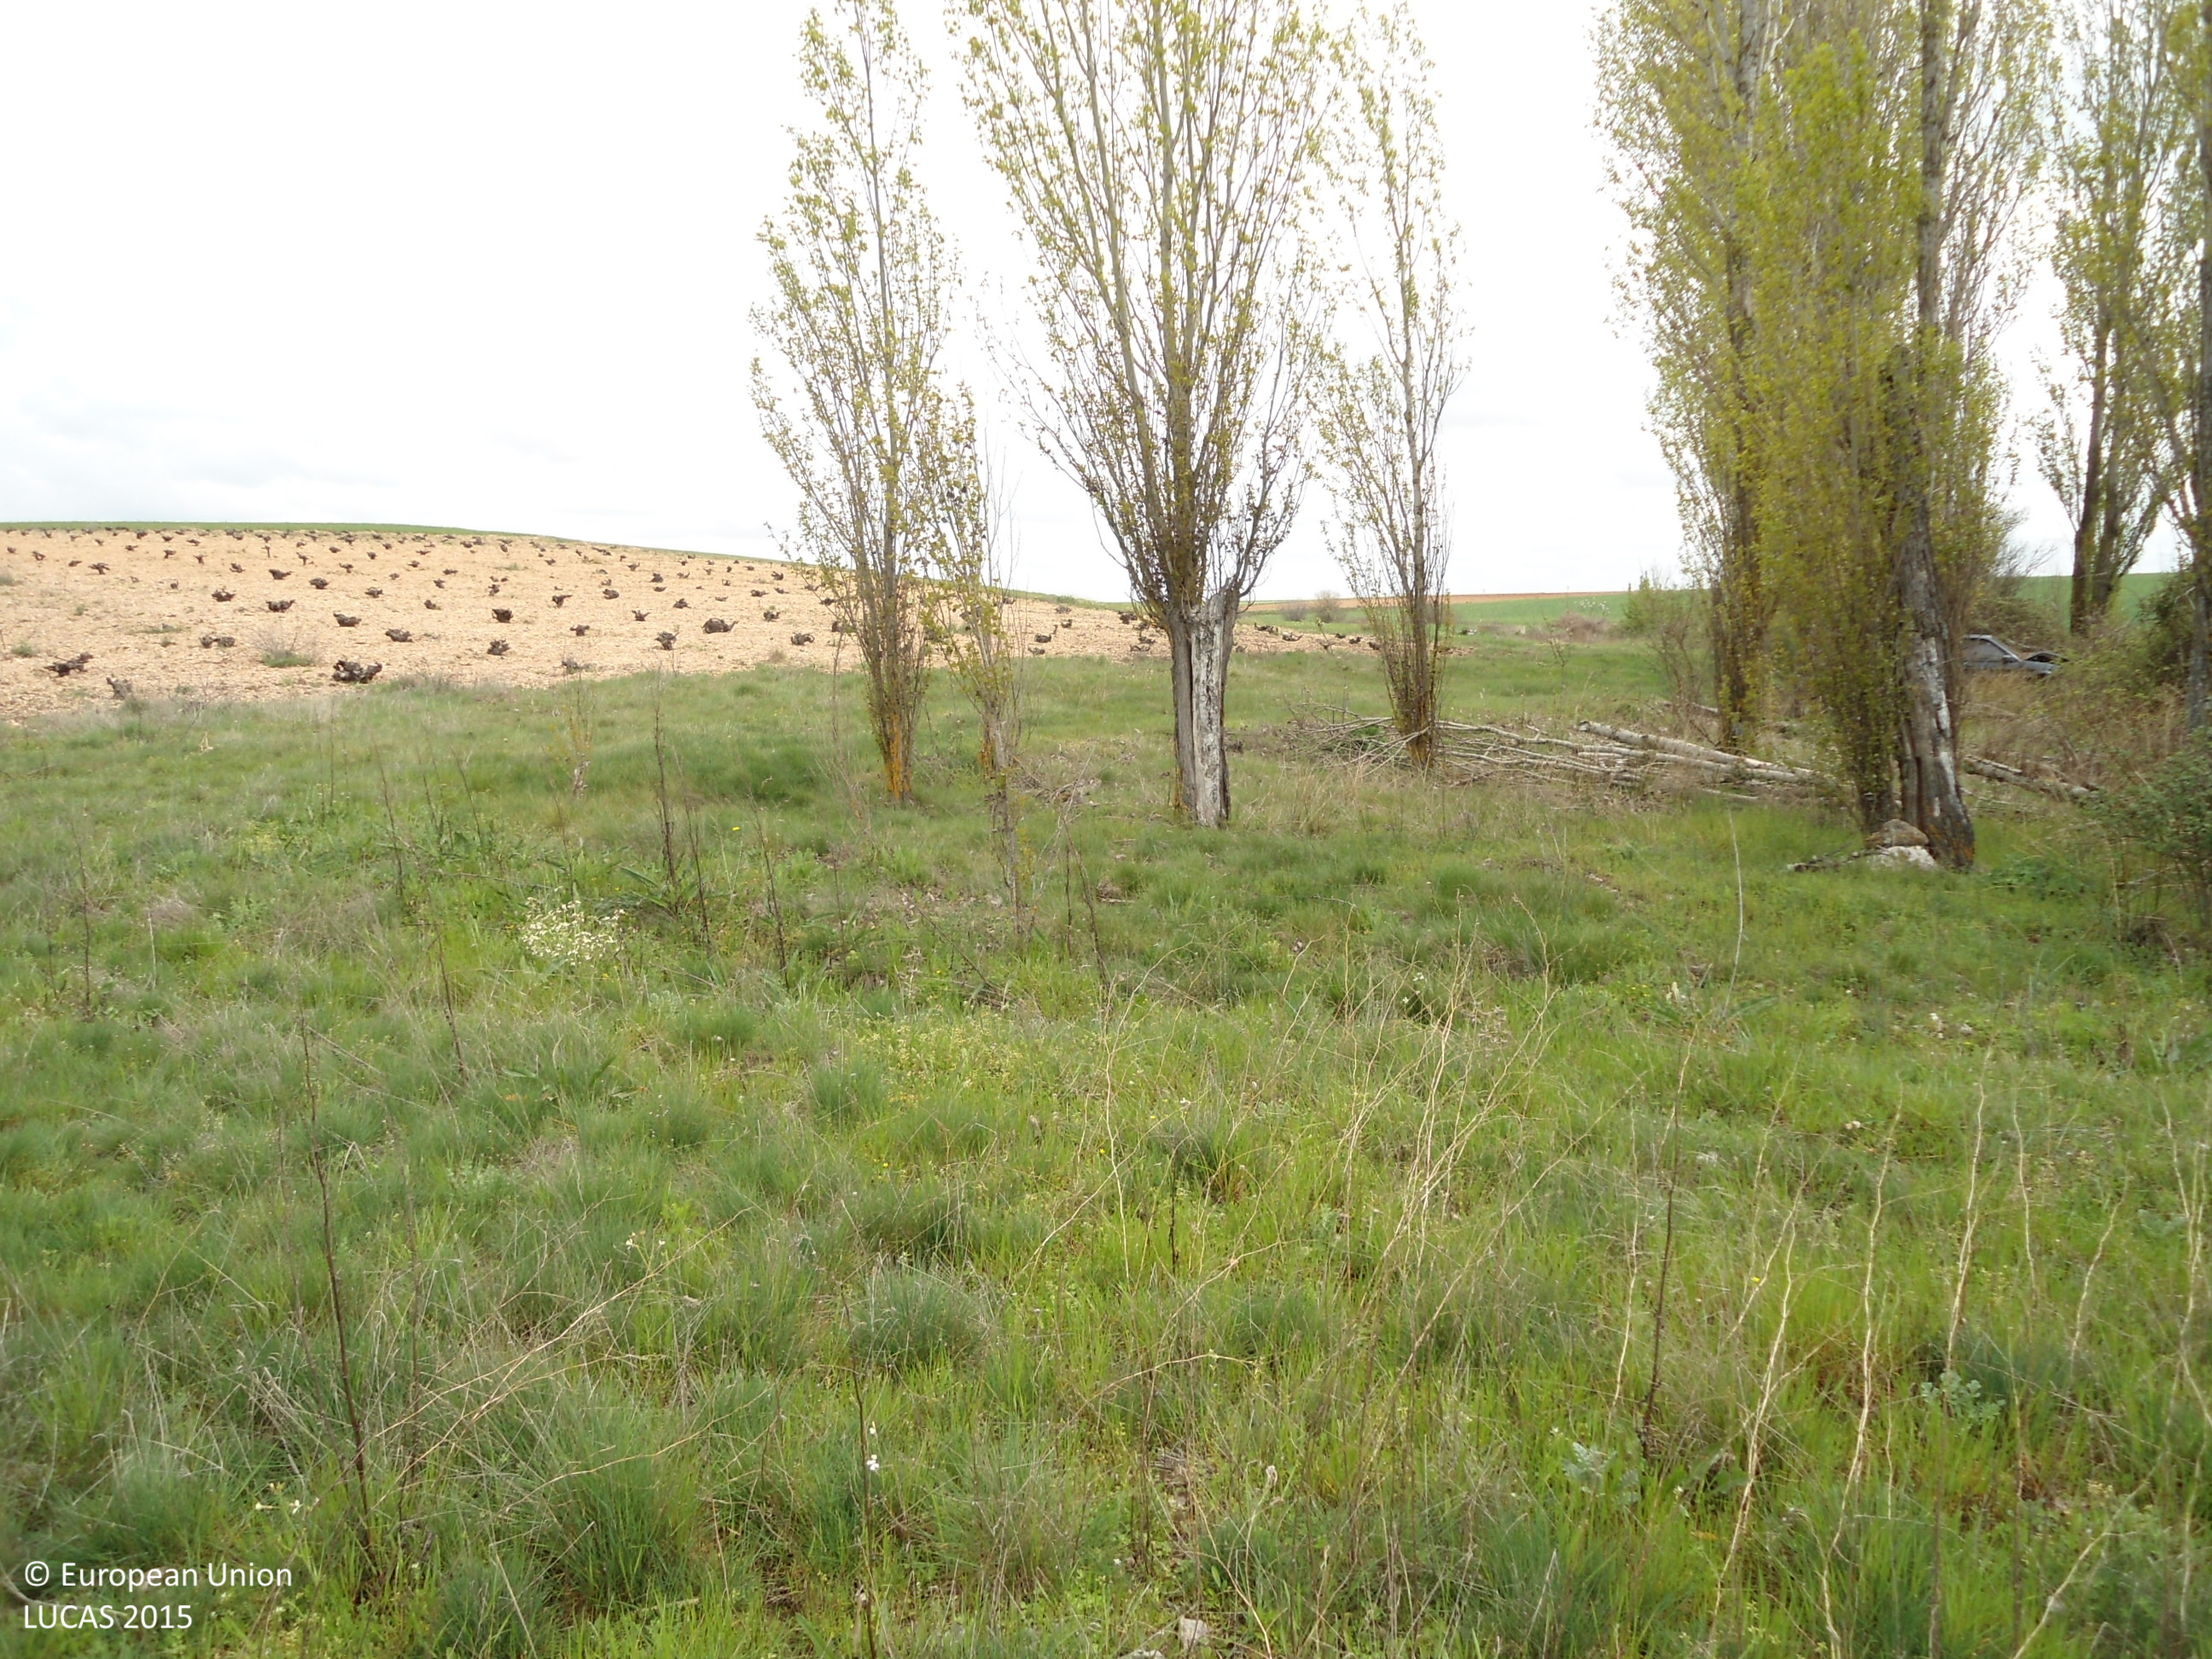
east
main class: Grassland
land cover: Spontaneously vegetated surfaces
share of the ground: > 75 %
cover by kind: herbaceous plants 95 %, shrubs 5 %
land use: Fallow land
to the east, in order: Spontaneously vegetated surfaces; Grassland with sparse tree/shrub cover; Broadleaved woodland; Tracks; Grassland with sparse tree/shrub cover; Vineyards; Tracks; Oats; Grass margins; Tracks; Grass margins; Grassland with sparse tree/shrub cover
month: April
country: ES
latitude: 41.5823
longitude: -5.8385
